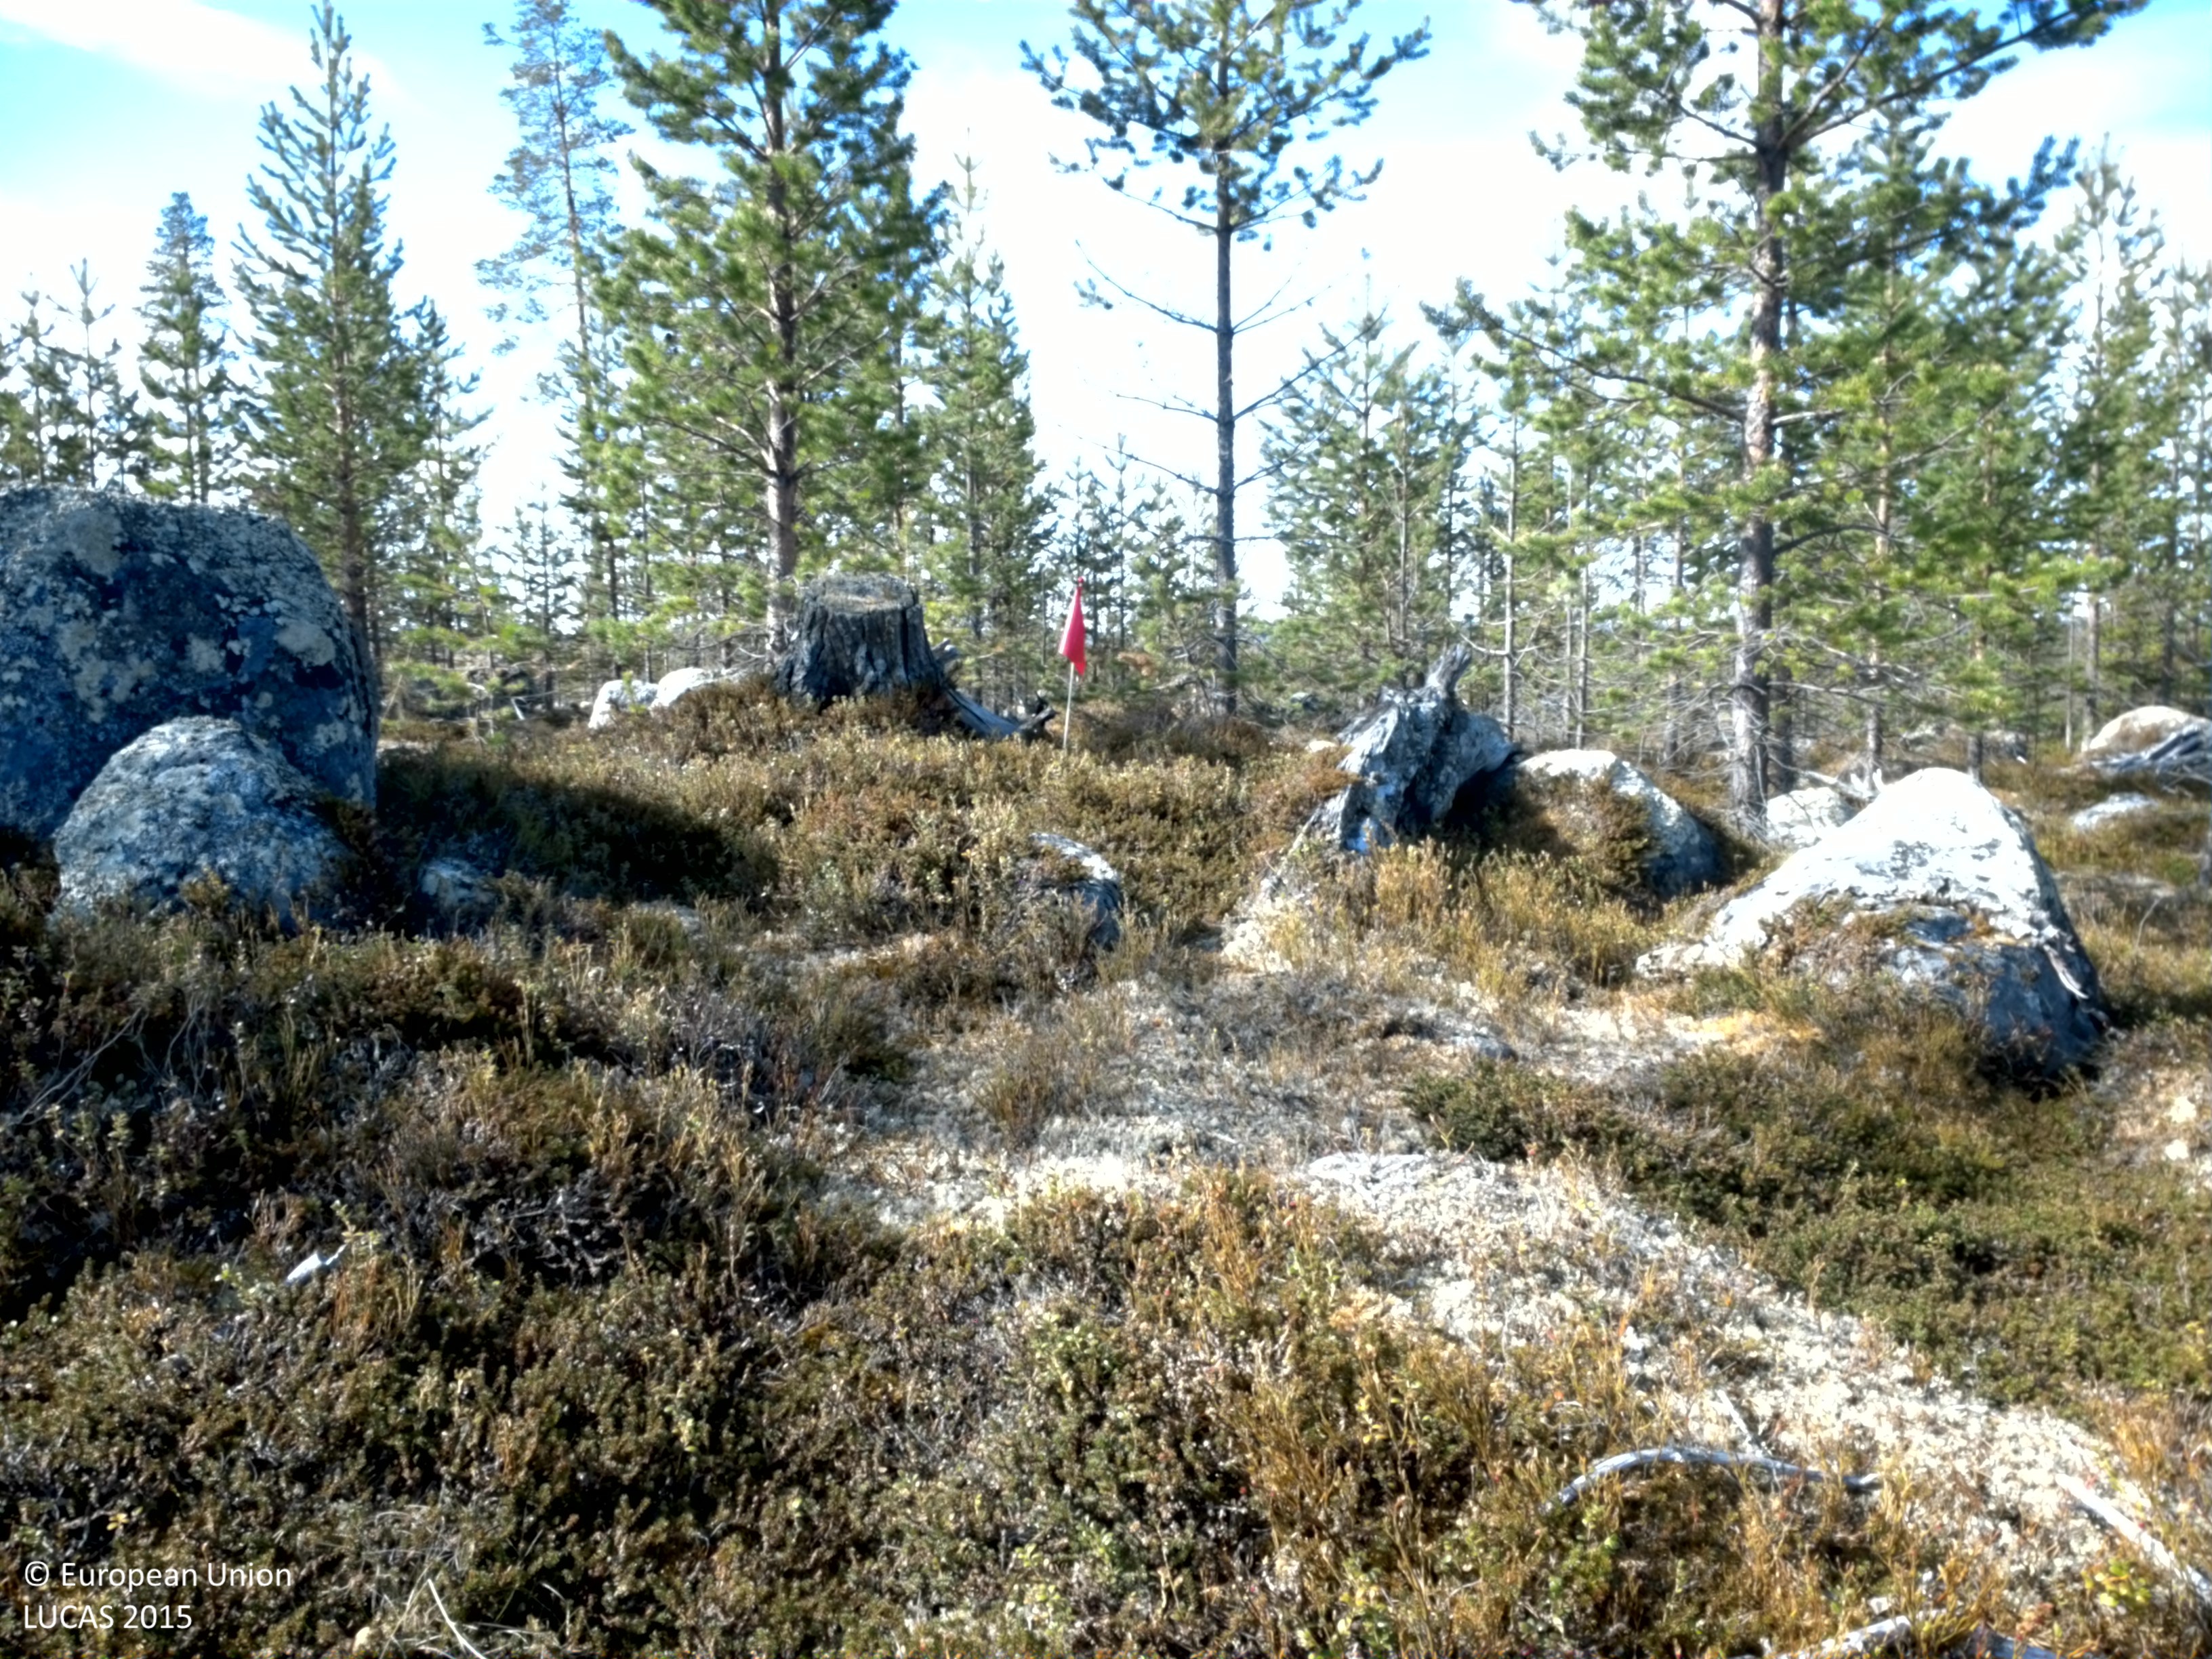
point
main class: Woodland
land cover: Pine dominated coniferous woodland
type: boreal forest
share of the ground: 10 - 25 %
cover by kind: shrubs 55 %, coniferous forest trees 20 %, consolidated bare surface 15 %, lichens and mosses 10 %
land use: Forestry
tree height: < 5 m
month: June
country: SE
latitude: 65.9413
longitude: 18.7276
